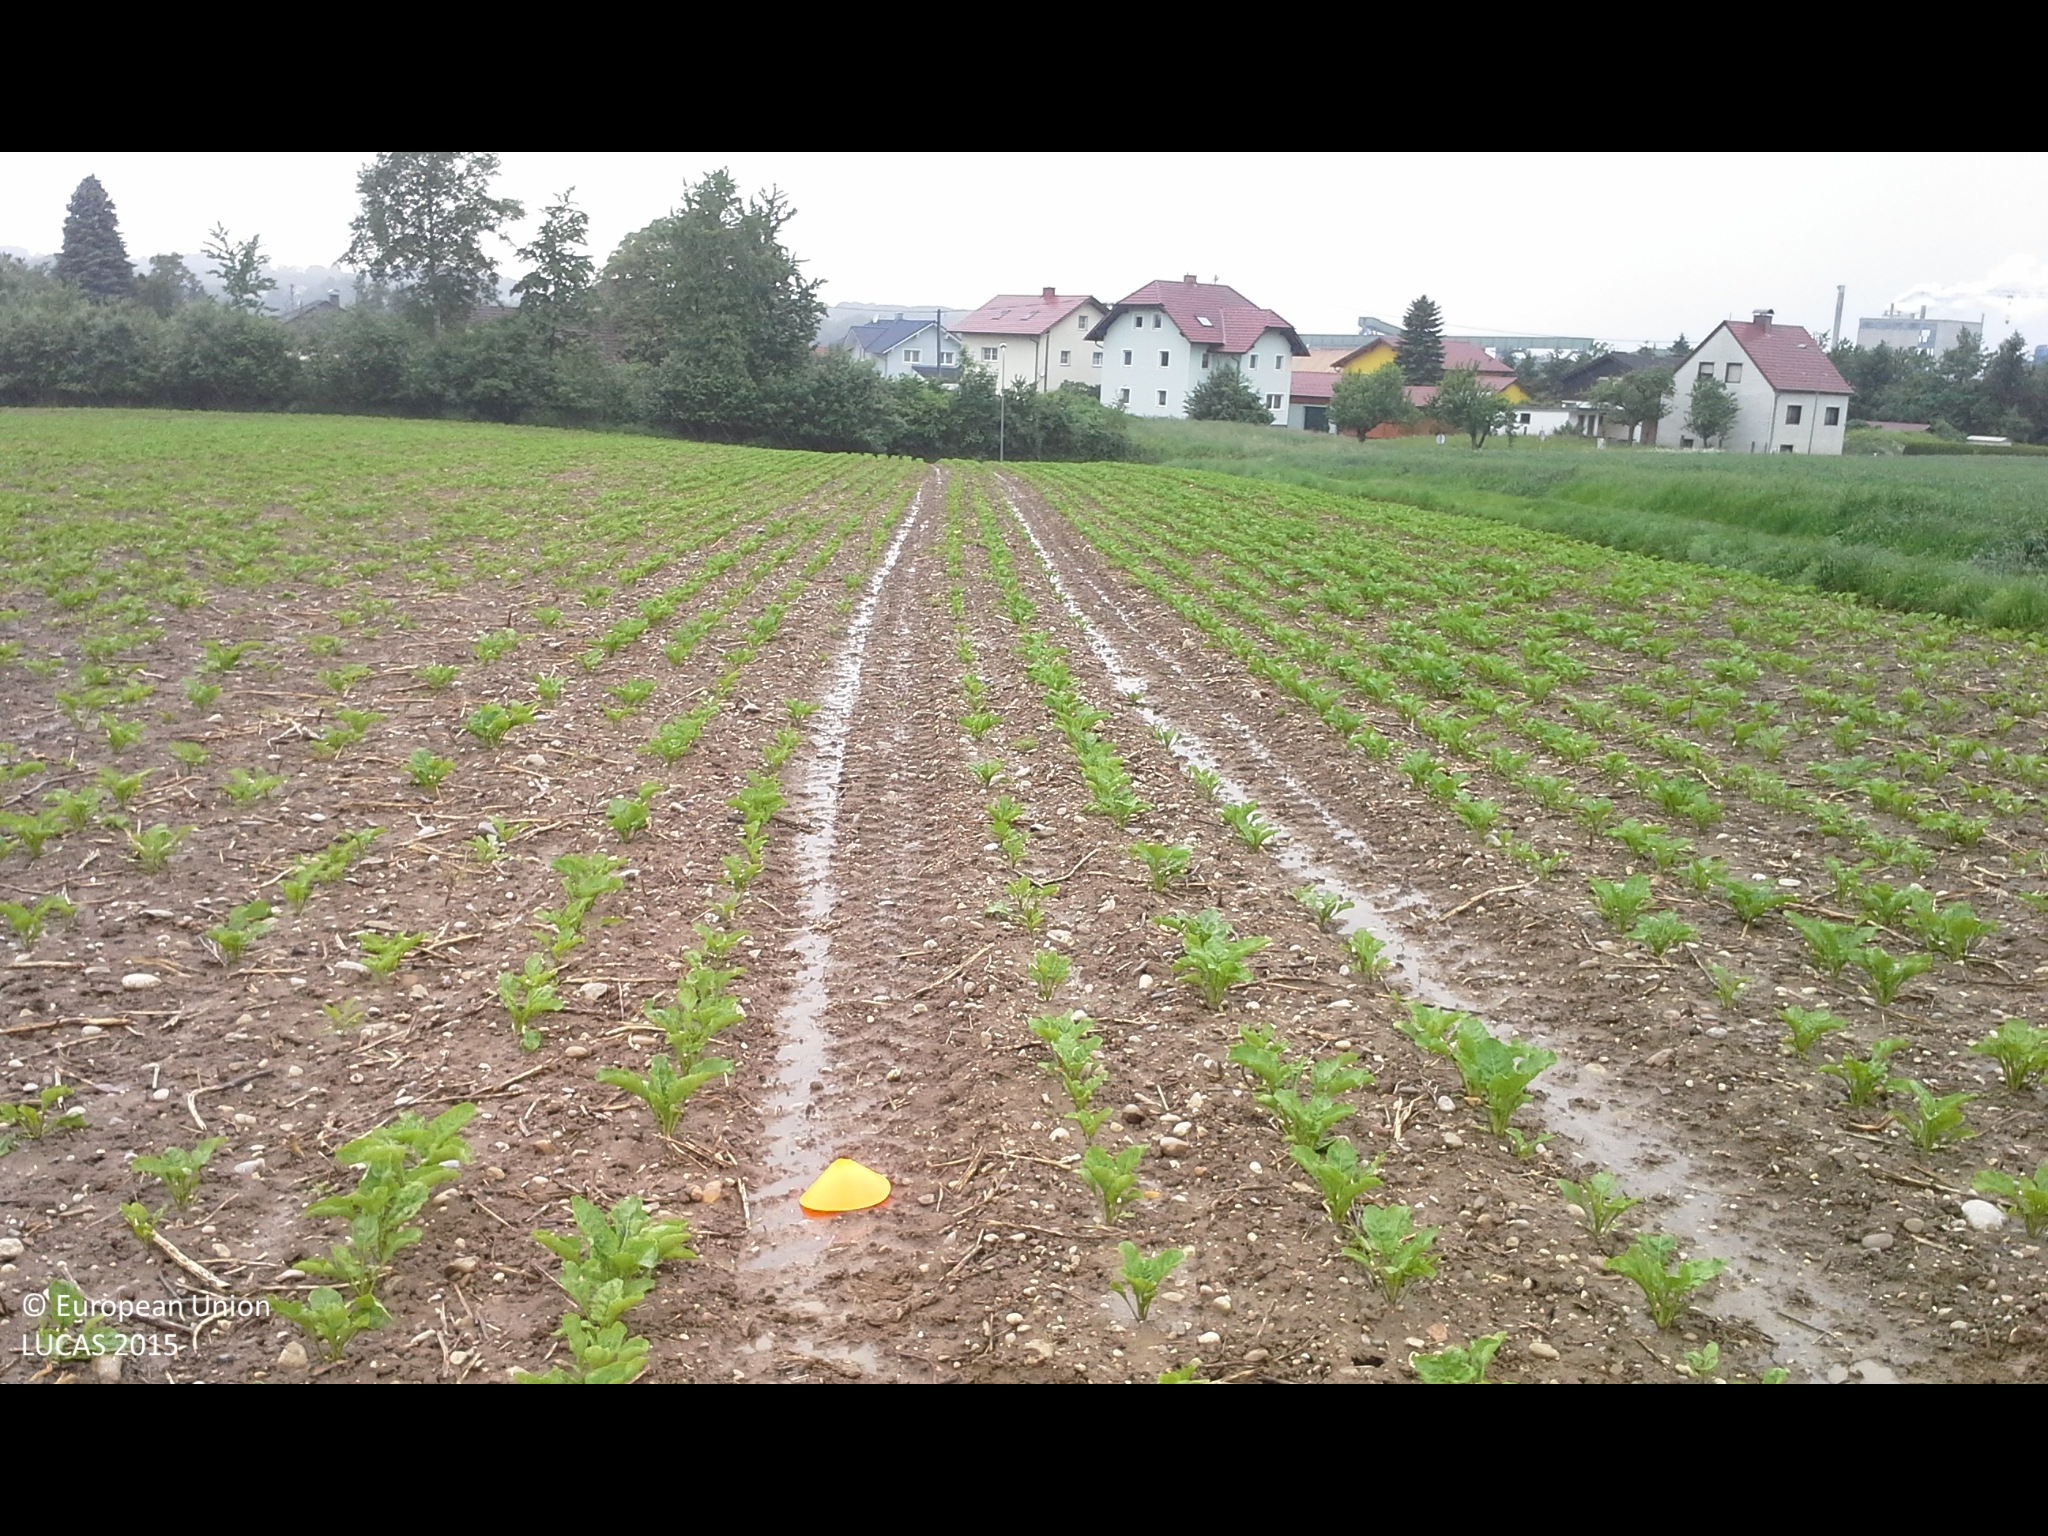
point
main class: Cropland
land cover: Sugar beet
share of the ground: 10 - 25 %
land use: Agriculture (excluding fallow land and kitchen gardens)
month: May
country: AT
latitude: 48.1772
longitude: 14.2631
